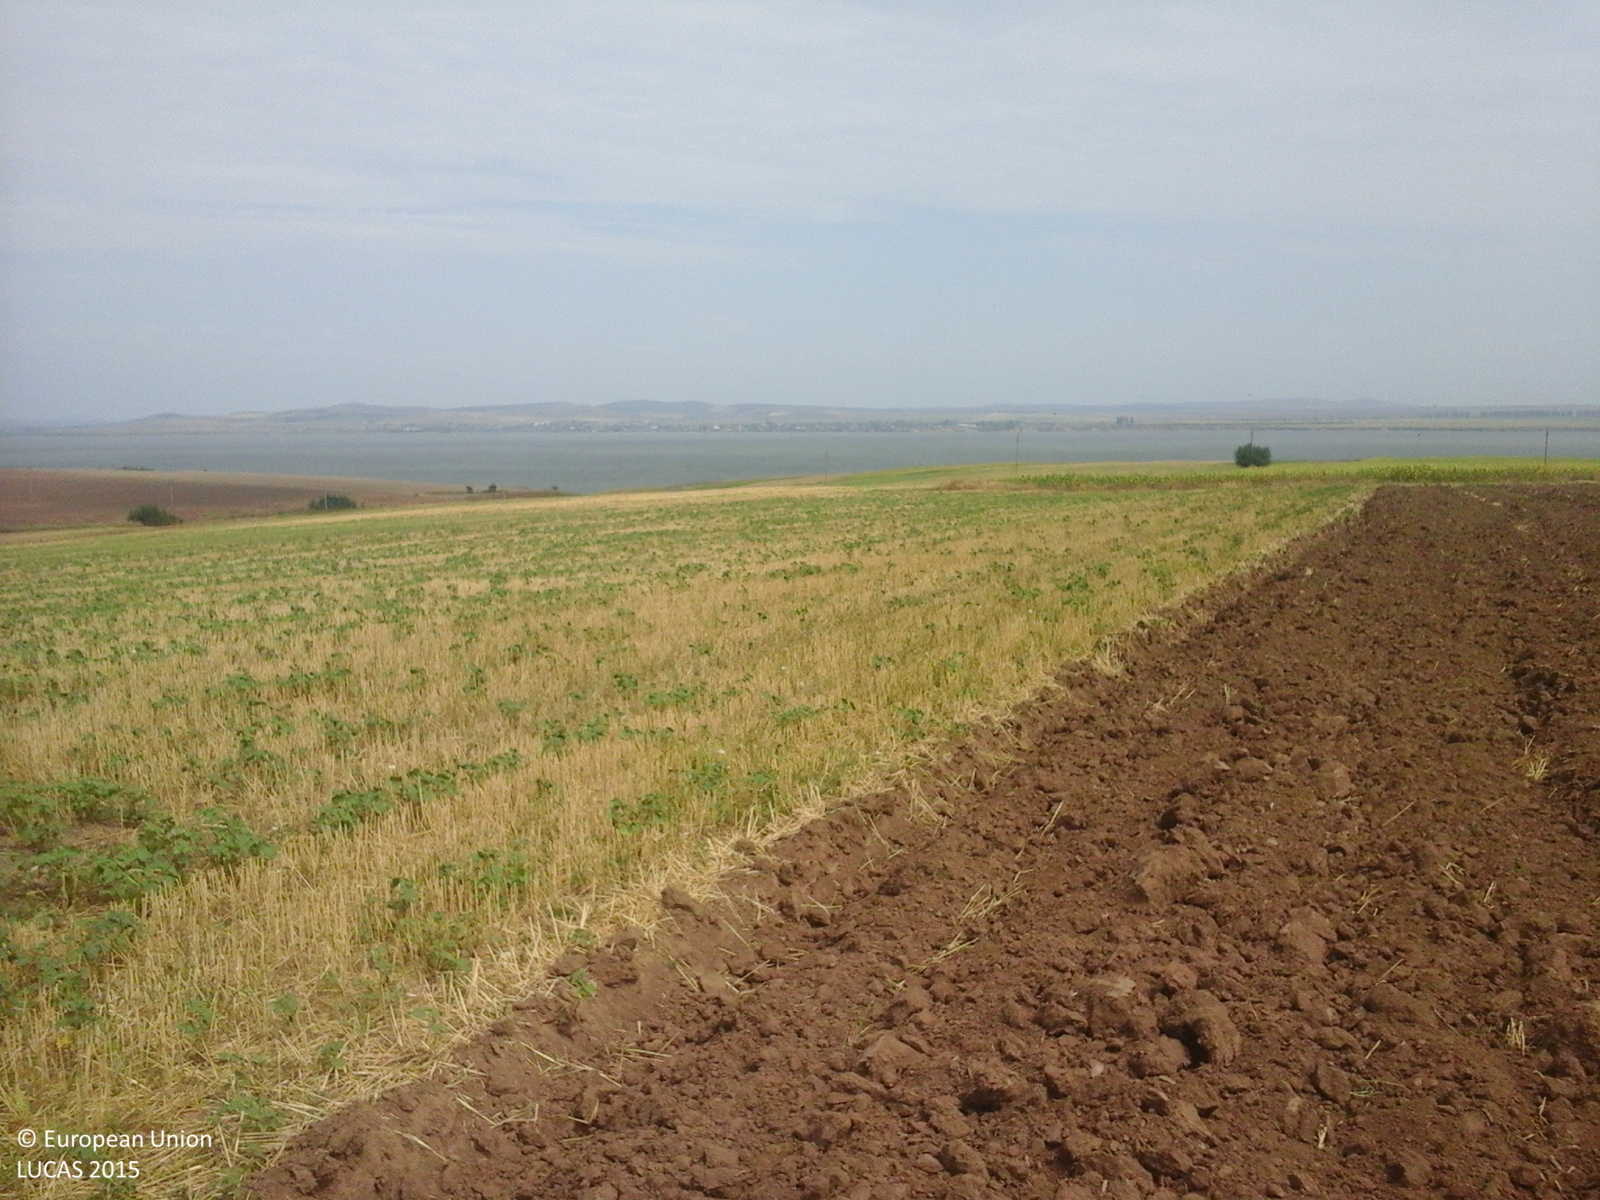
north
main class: Cropland
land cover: Common wheat
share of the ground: < 10 %
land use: Agriculture (excluding fallow land and kitchen gardens)
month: August
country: RO
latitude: 44.8929
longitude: 28.7628
